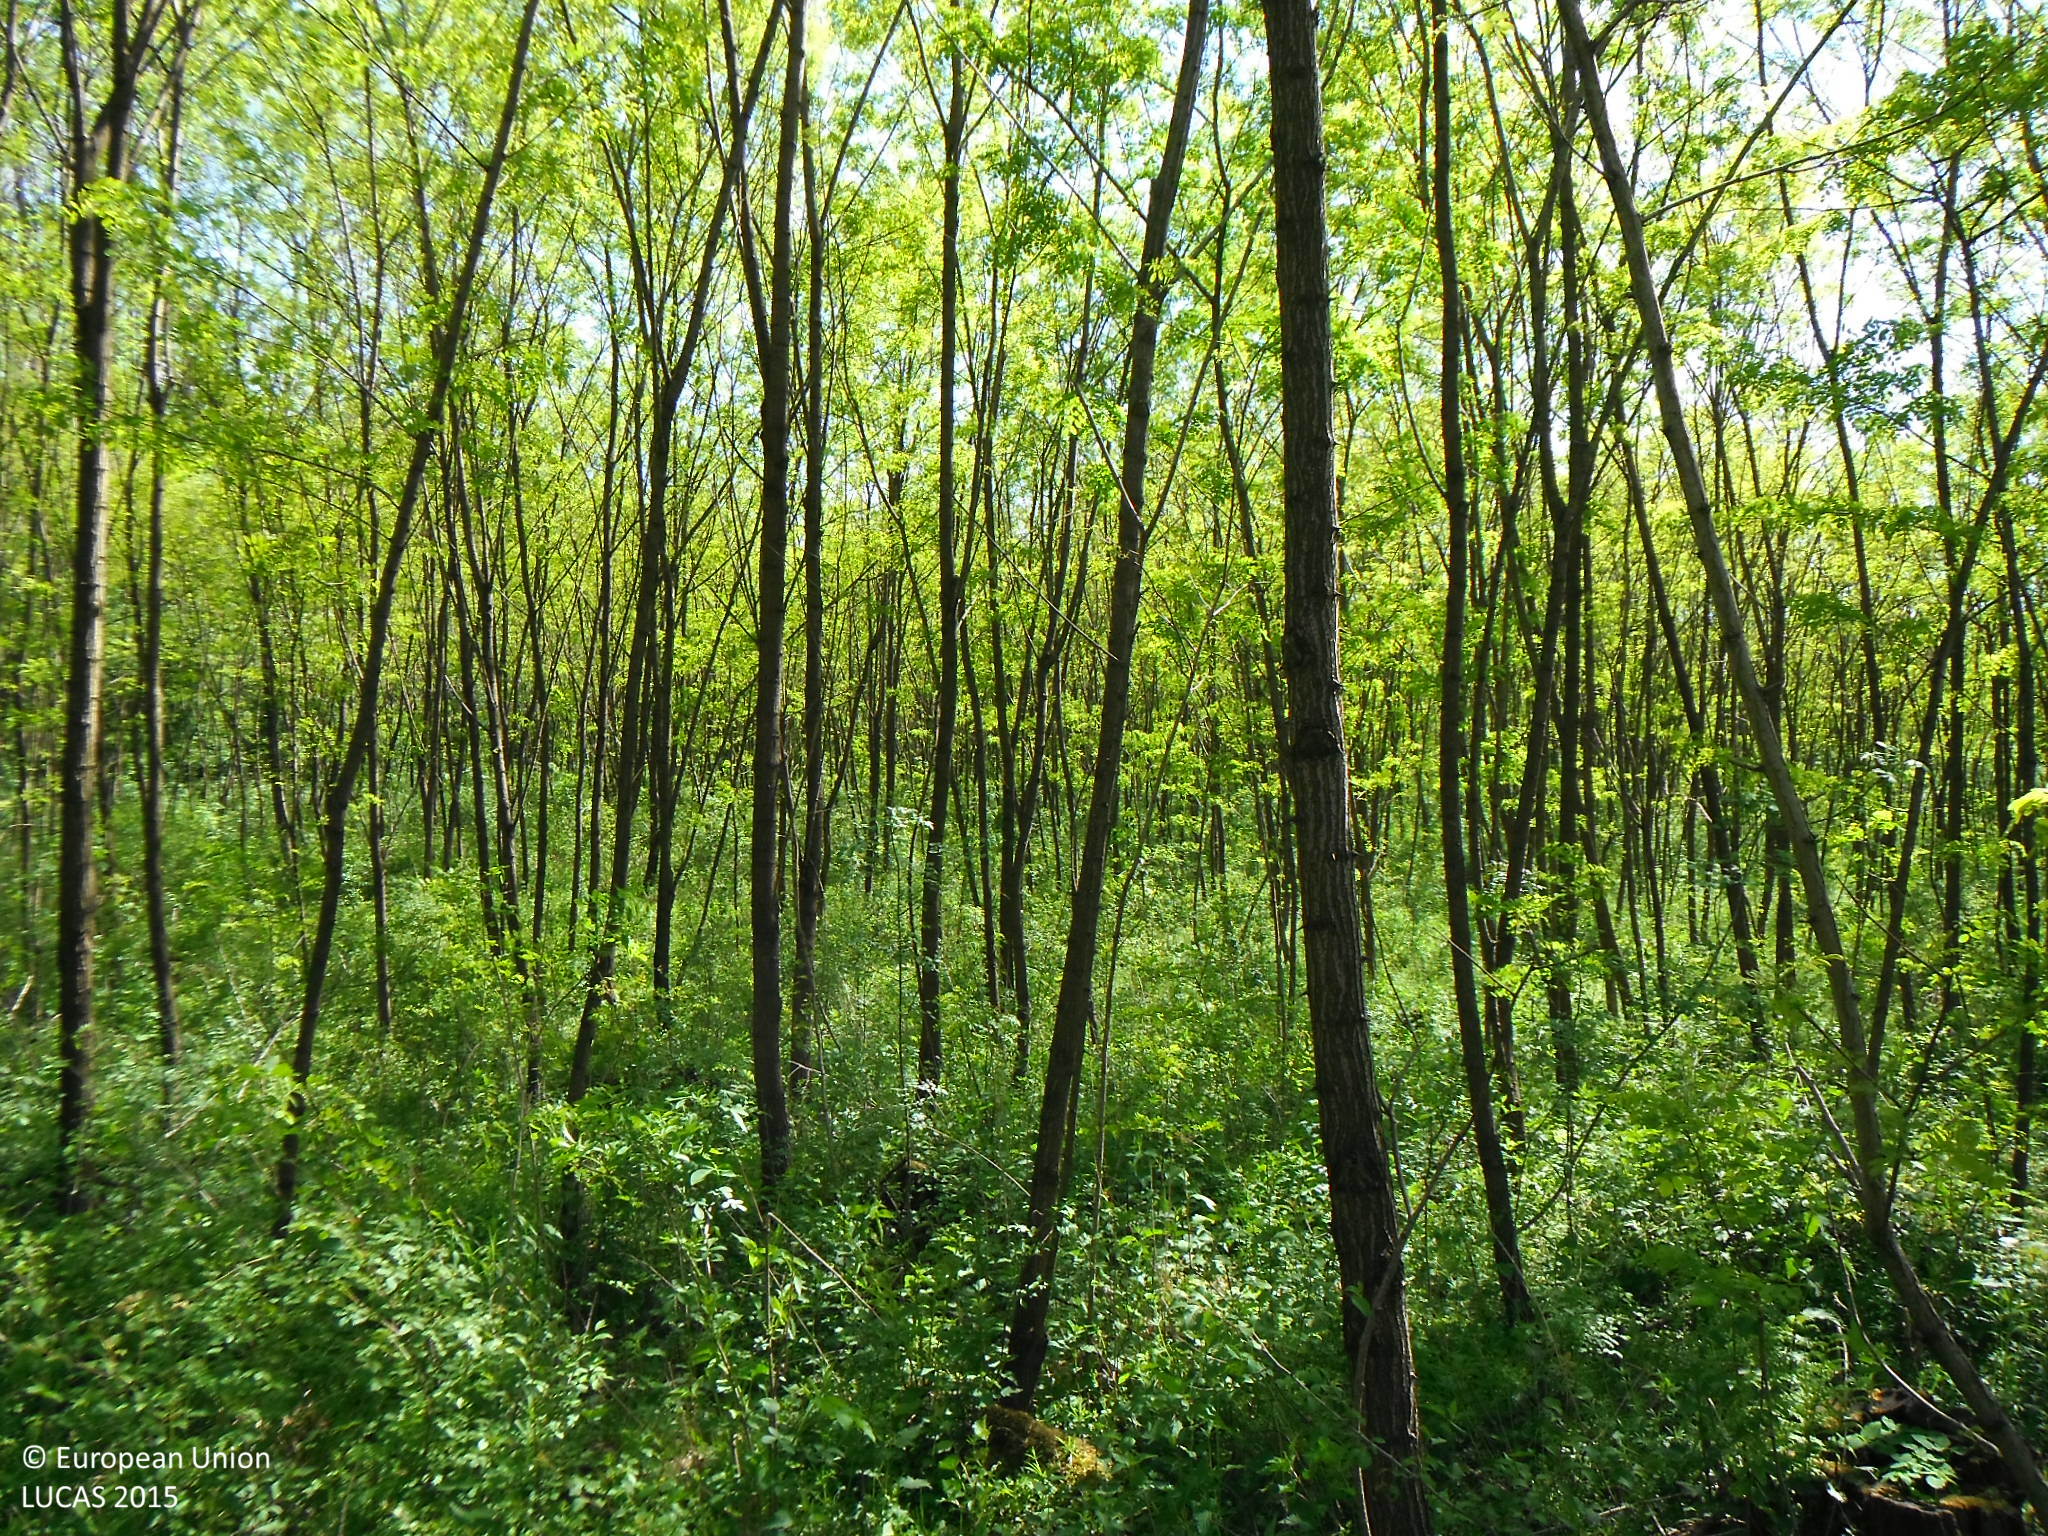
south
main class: Woodland
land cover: Broadleaved woodland
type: exotic forest
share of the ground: > 75 %
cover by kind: broadleaved forest trees 80 %, herbaceous plants 20 %
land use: Forestry
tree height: > 5 m
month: May
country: SK
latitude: 48.4940
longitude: 21.1250
